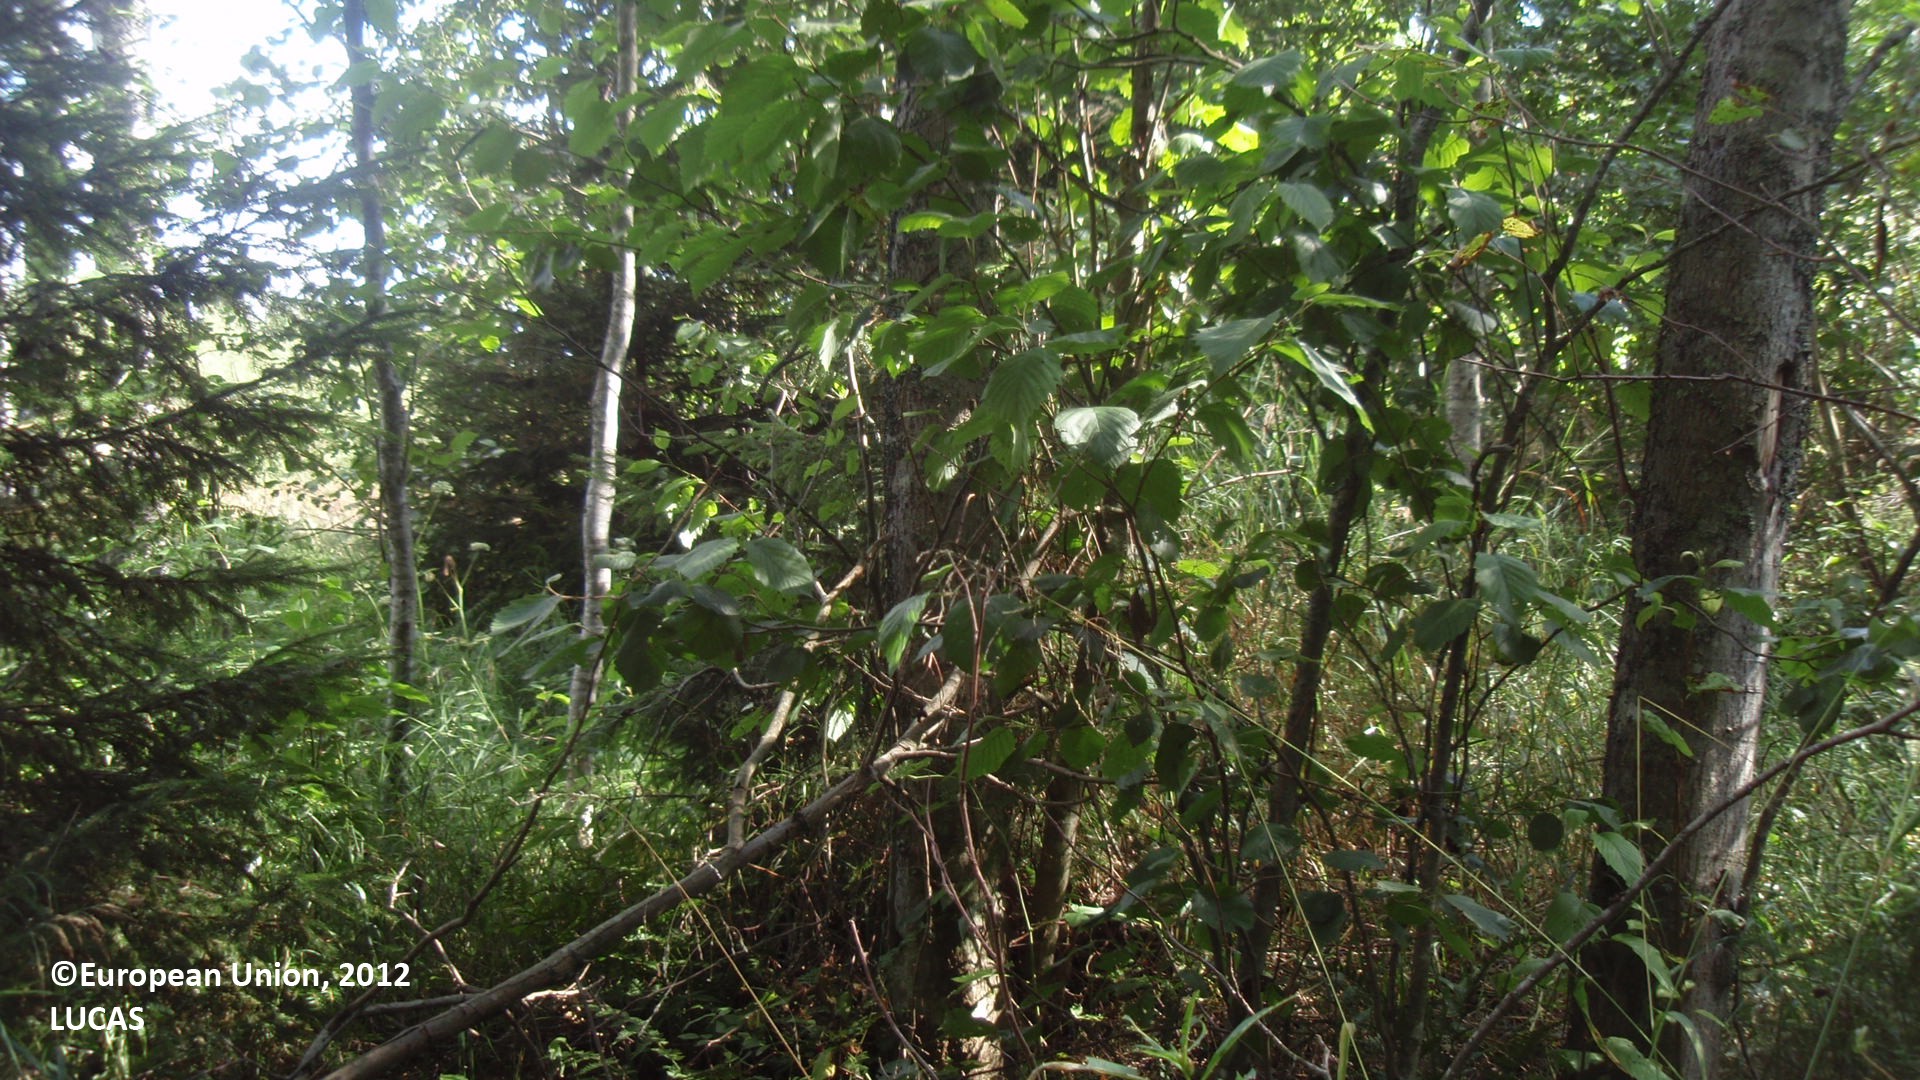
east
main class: Woodland
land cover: Spruce dominated mixed woodland
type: boreal forest
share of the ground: 50 - 75 %
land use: Forestry
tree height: > 5 m
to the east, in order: Spruce dominated mixed woodland; Ditches and canals; Broadleaved woodland; Spruce dominated mixed woodland; Broadleaved woodland; Spruce dominated mixed woodland; Pine dominated mixed woodland
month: August
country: FI
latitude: 60.8020
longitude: 26.6793
